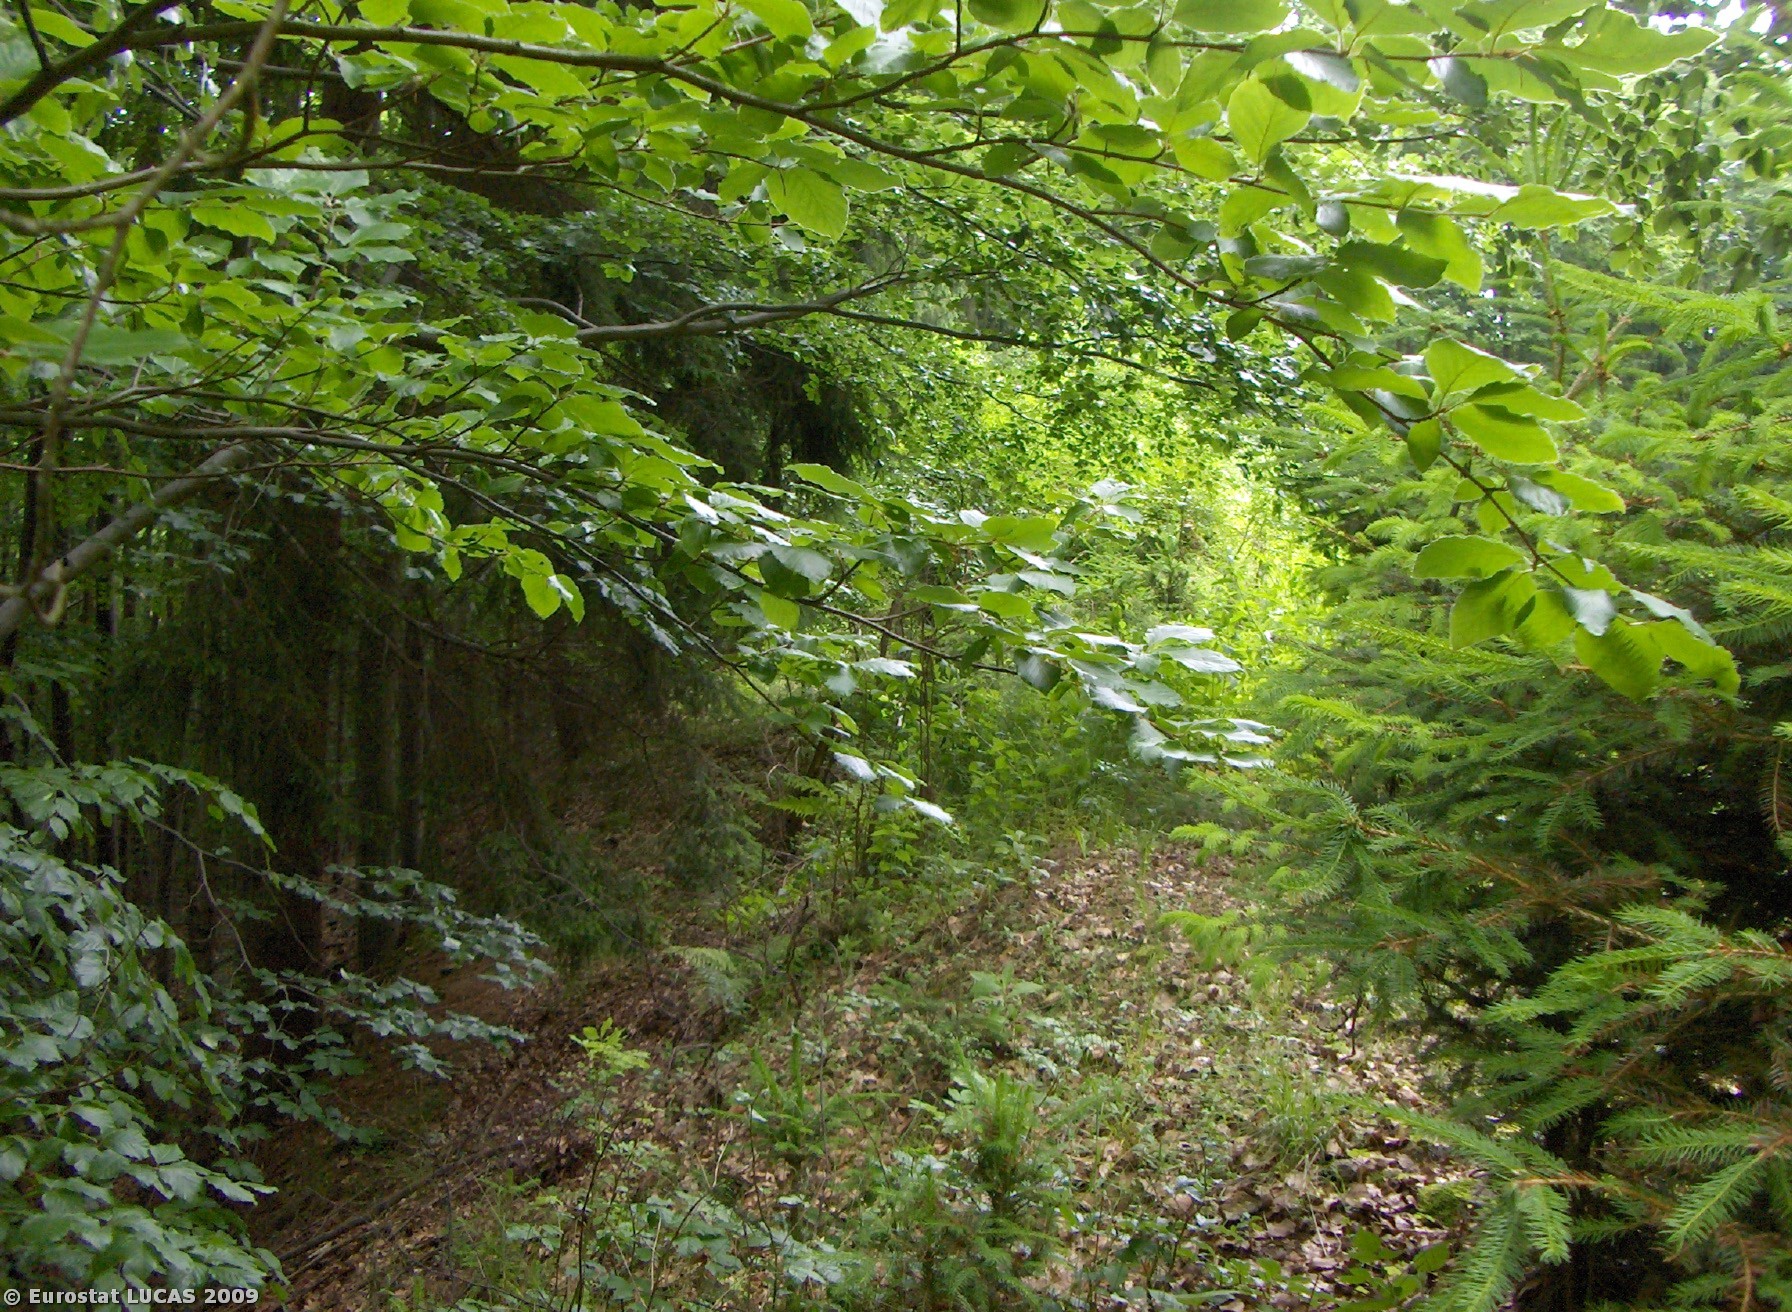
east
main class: Woodland
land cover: Mixed woodland
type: hemiboreal forest and nemoral coniferous forest and mixed broadleaved-coniferous forest
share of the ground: > 75 %
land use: Forestry
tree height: > 5 m
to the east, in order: Mixed woodland; Broadleaved woodland
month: May
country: CZ
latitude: 49.1066
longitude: 14.4531
